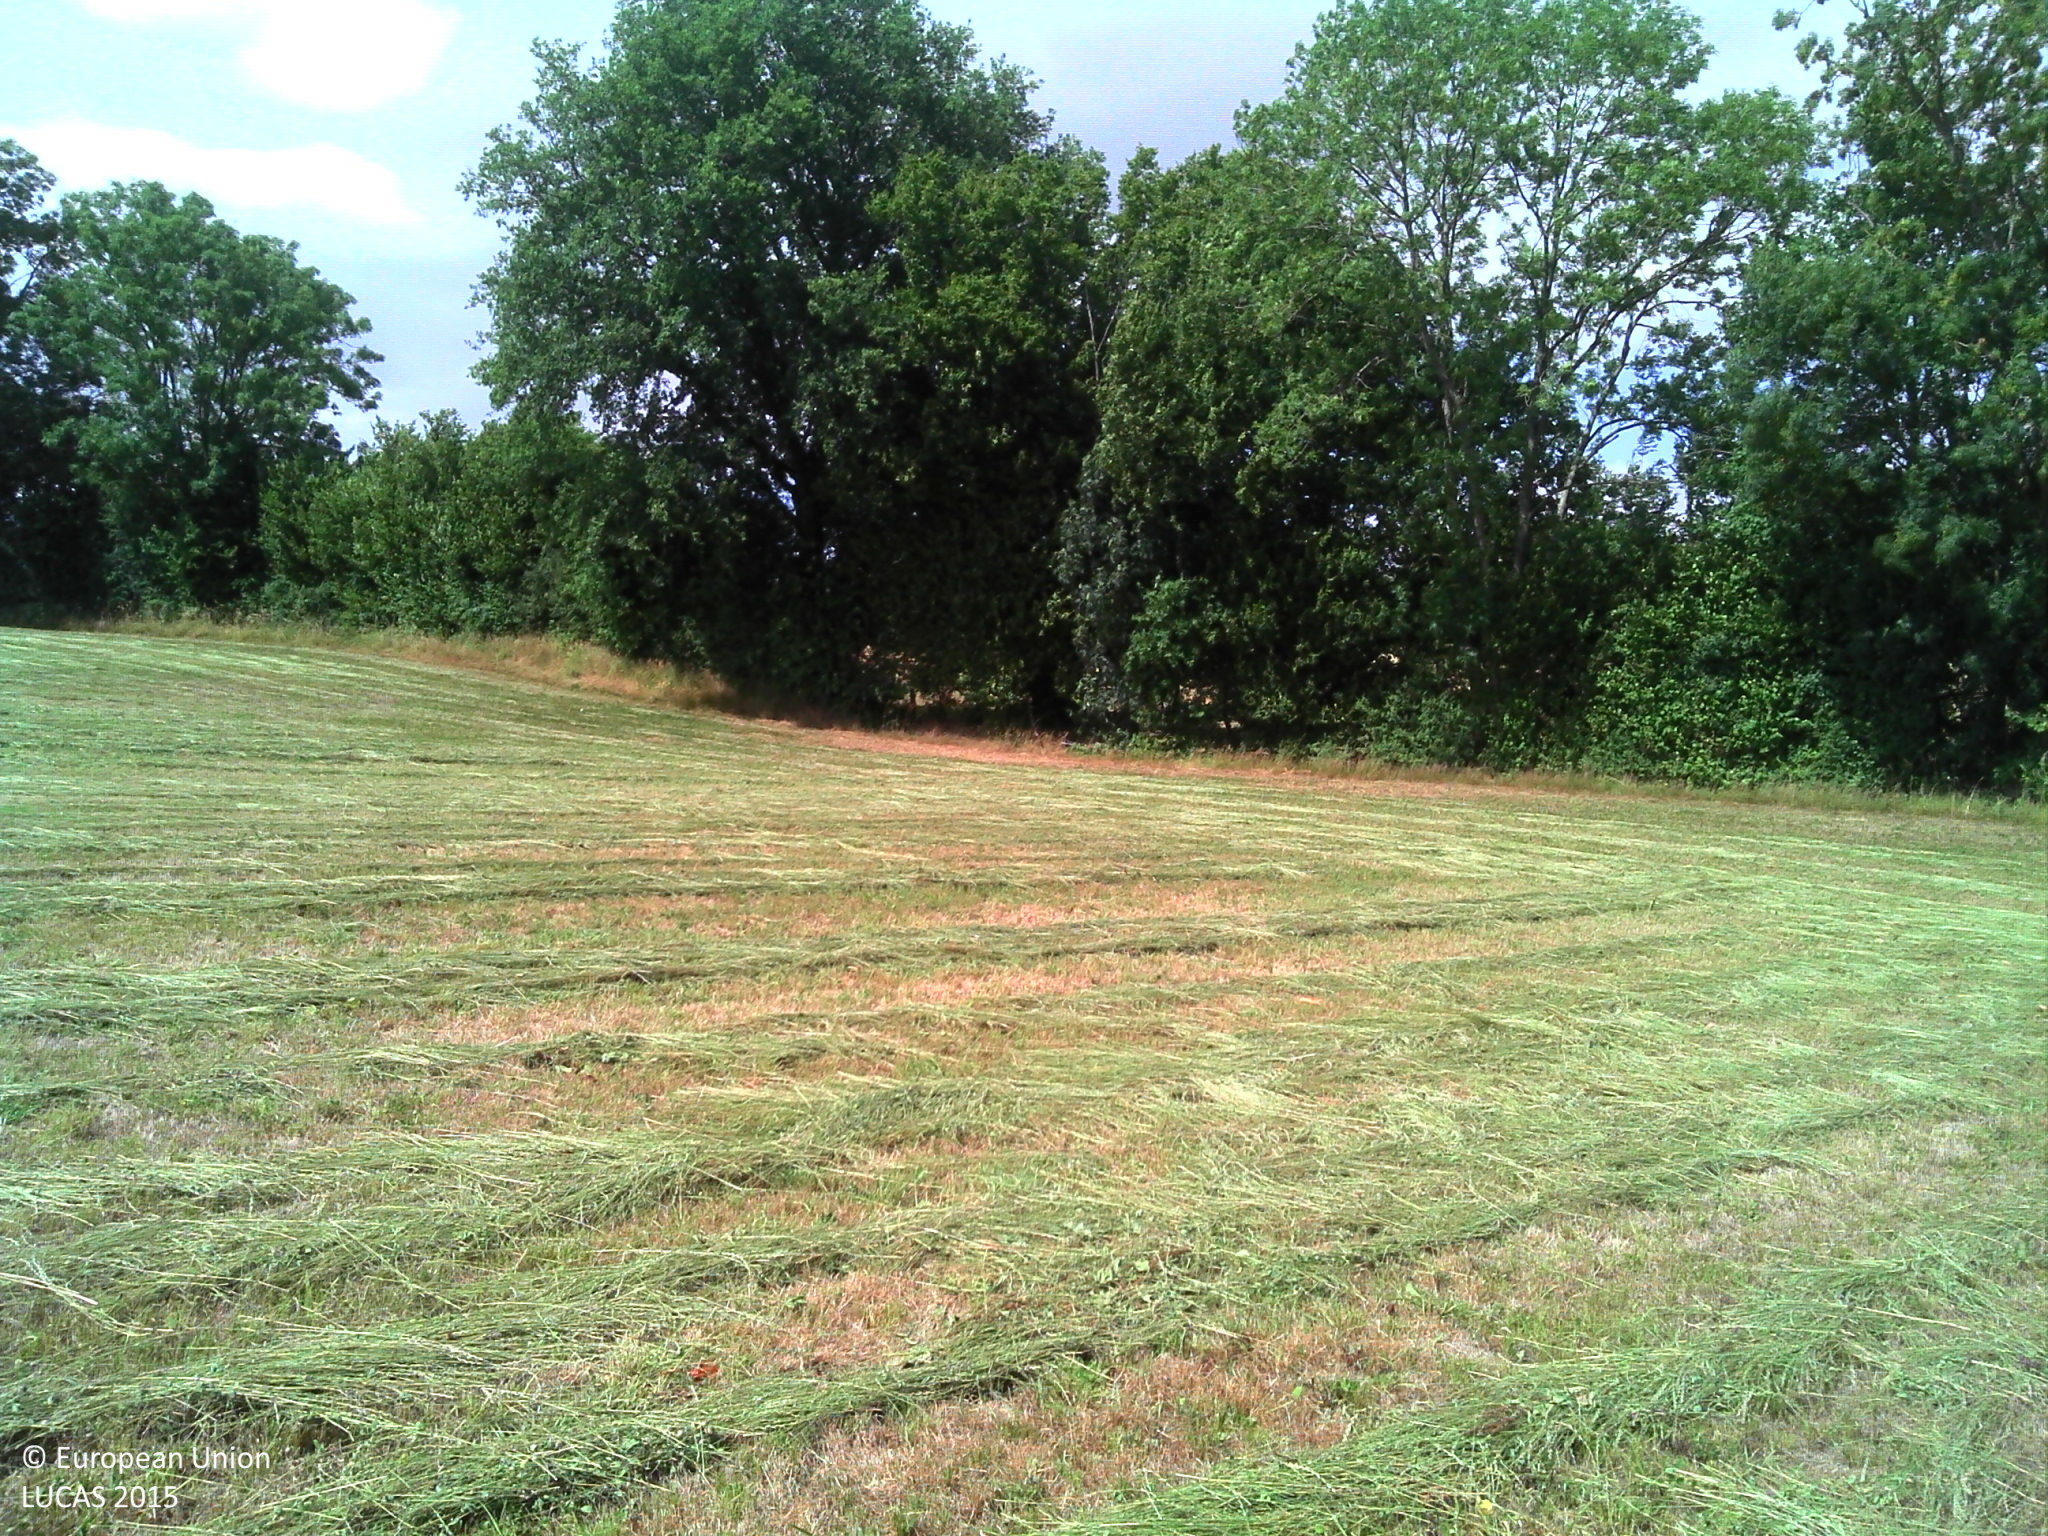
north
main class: Grassland
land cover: Grassland without tree/shrub cover
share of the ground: > 75 %
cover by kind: herbaceous plants 100 %
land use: Agriculture (excluding fallow land and kitchen gardens)
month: July
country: FR
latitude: 48.2396
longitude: 0.8361
